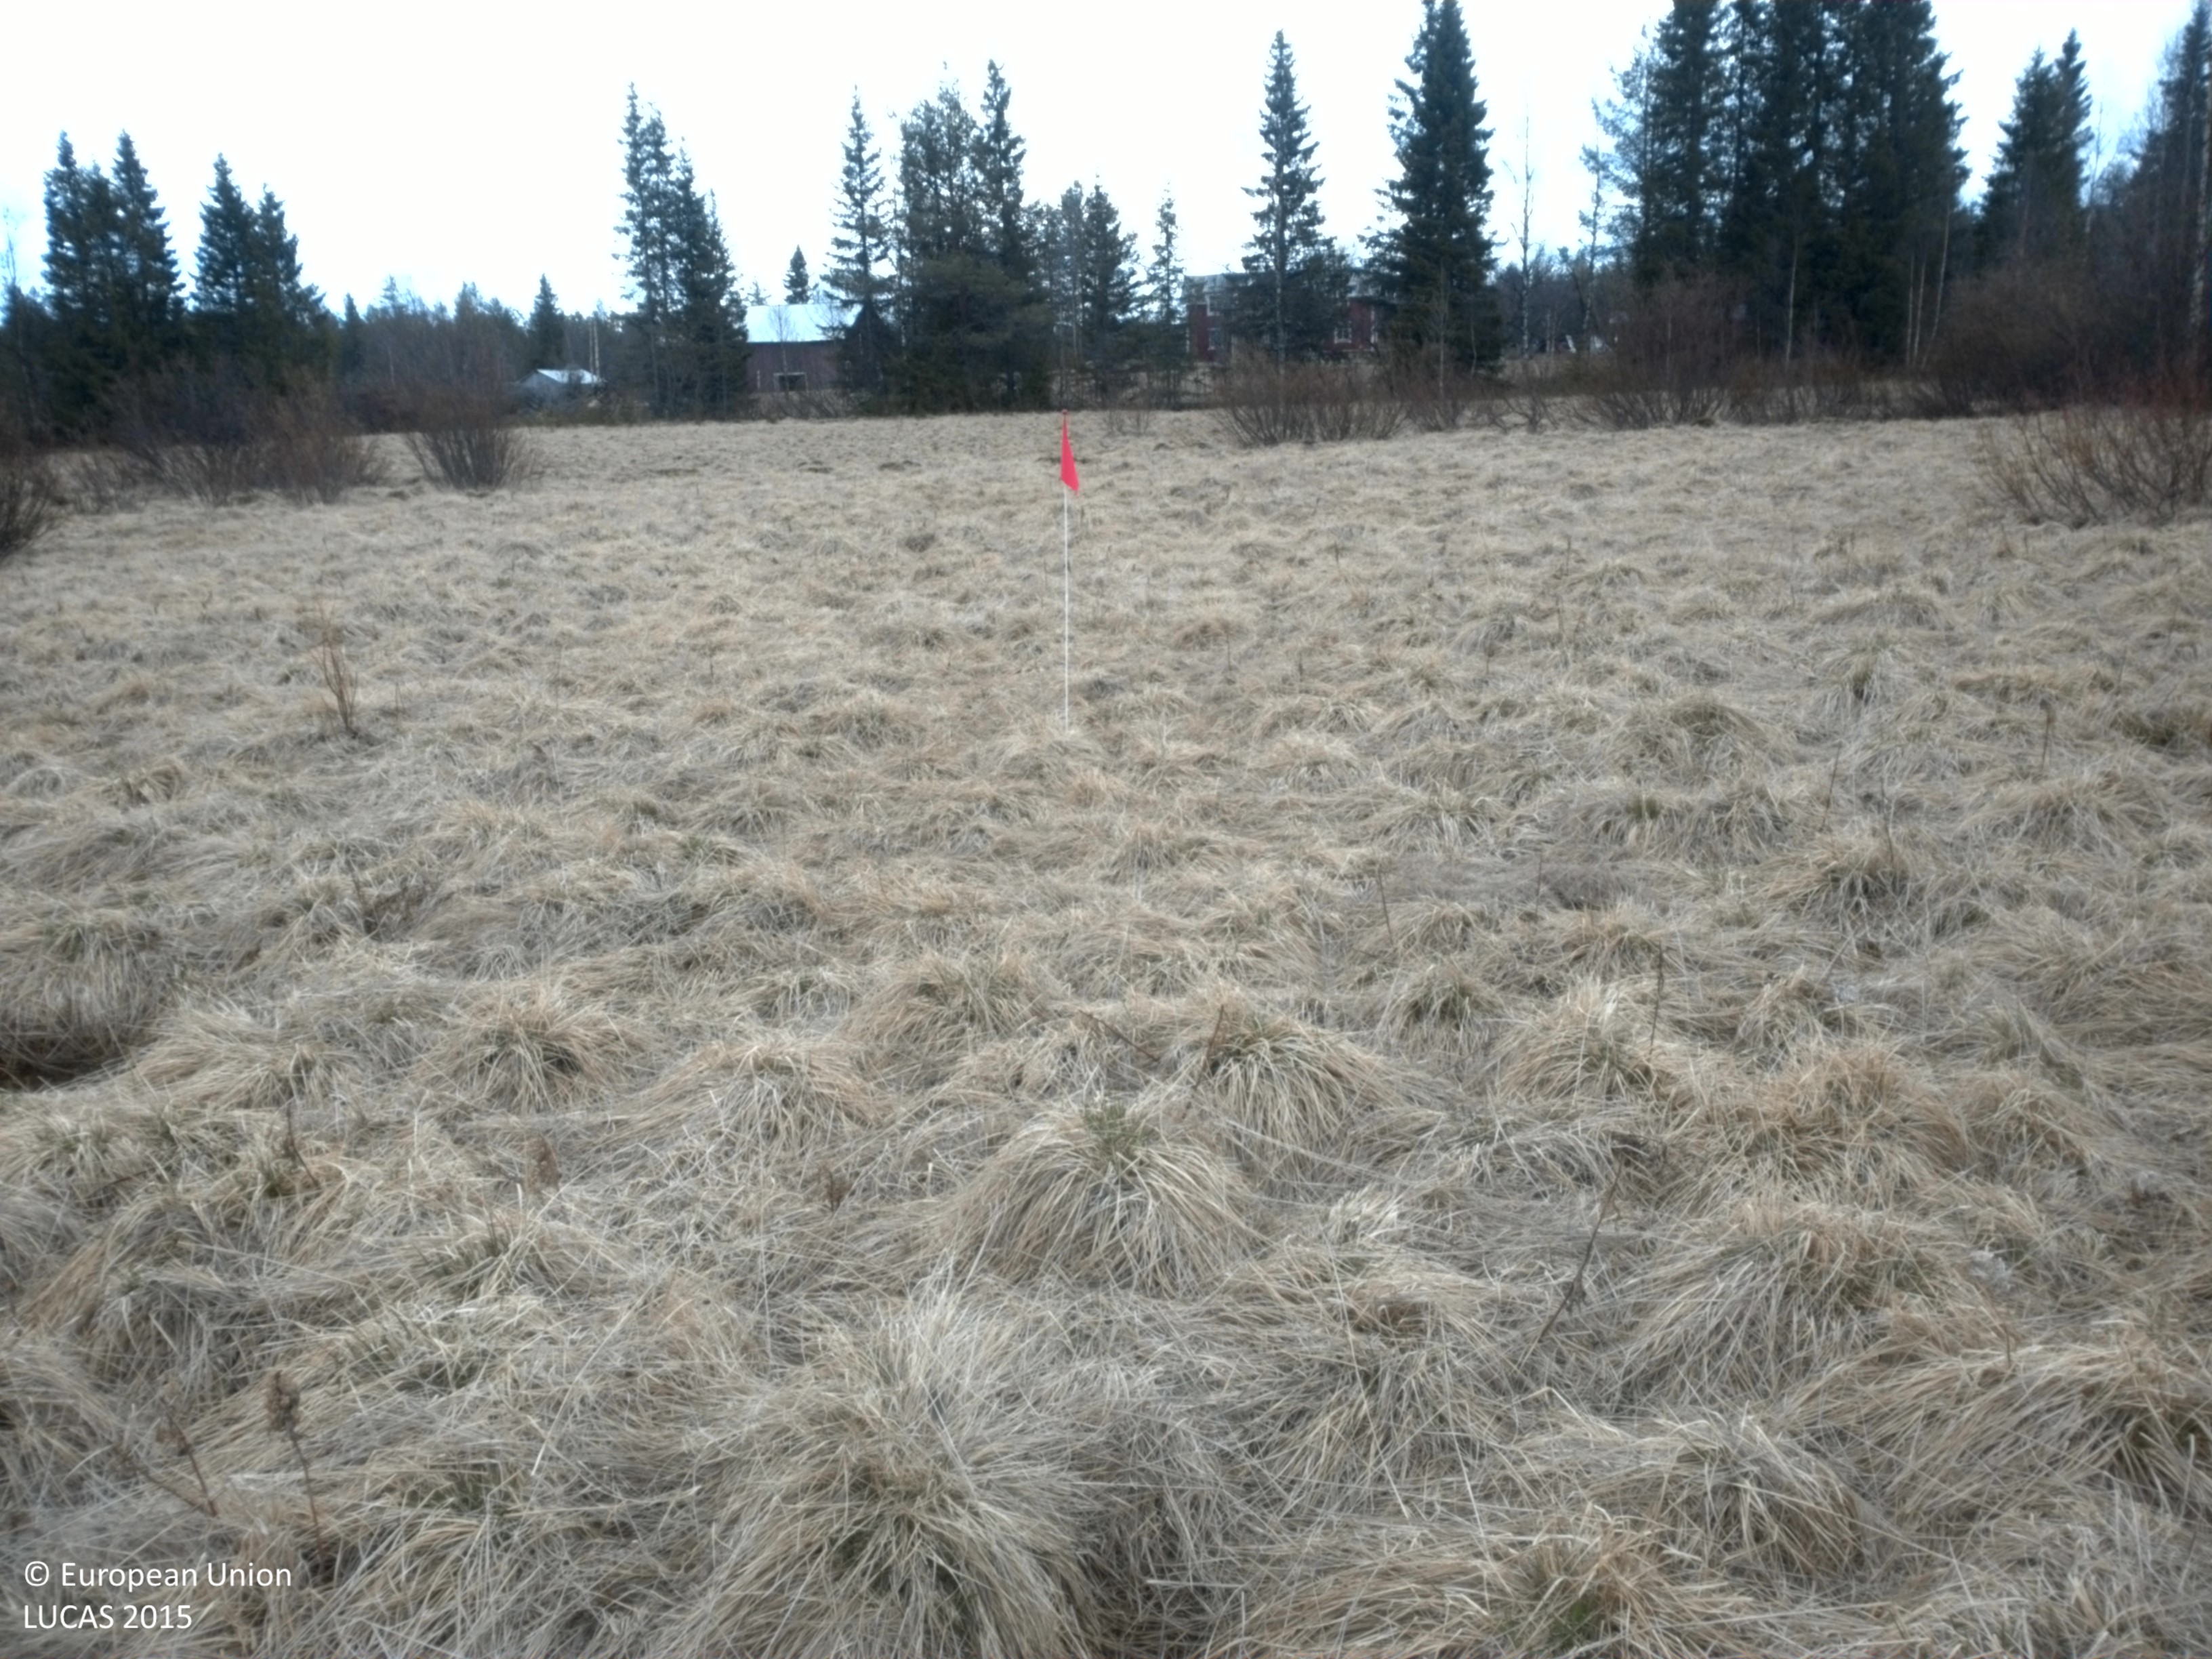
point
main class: Grassland
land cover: Grassland without tree/shrub cover
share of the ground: > 75 %
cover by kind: herbaceous plants 100 %
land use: Abandoned areas
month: May
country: SE
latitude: 64.2900
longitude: 18.2956
